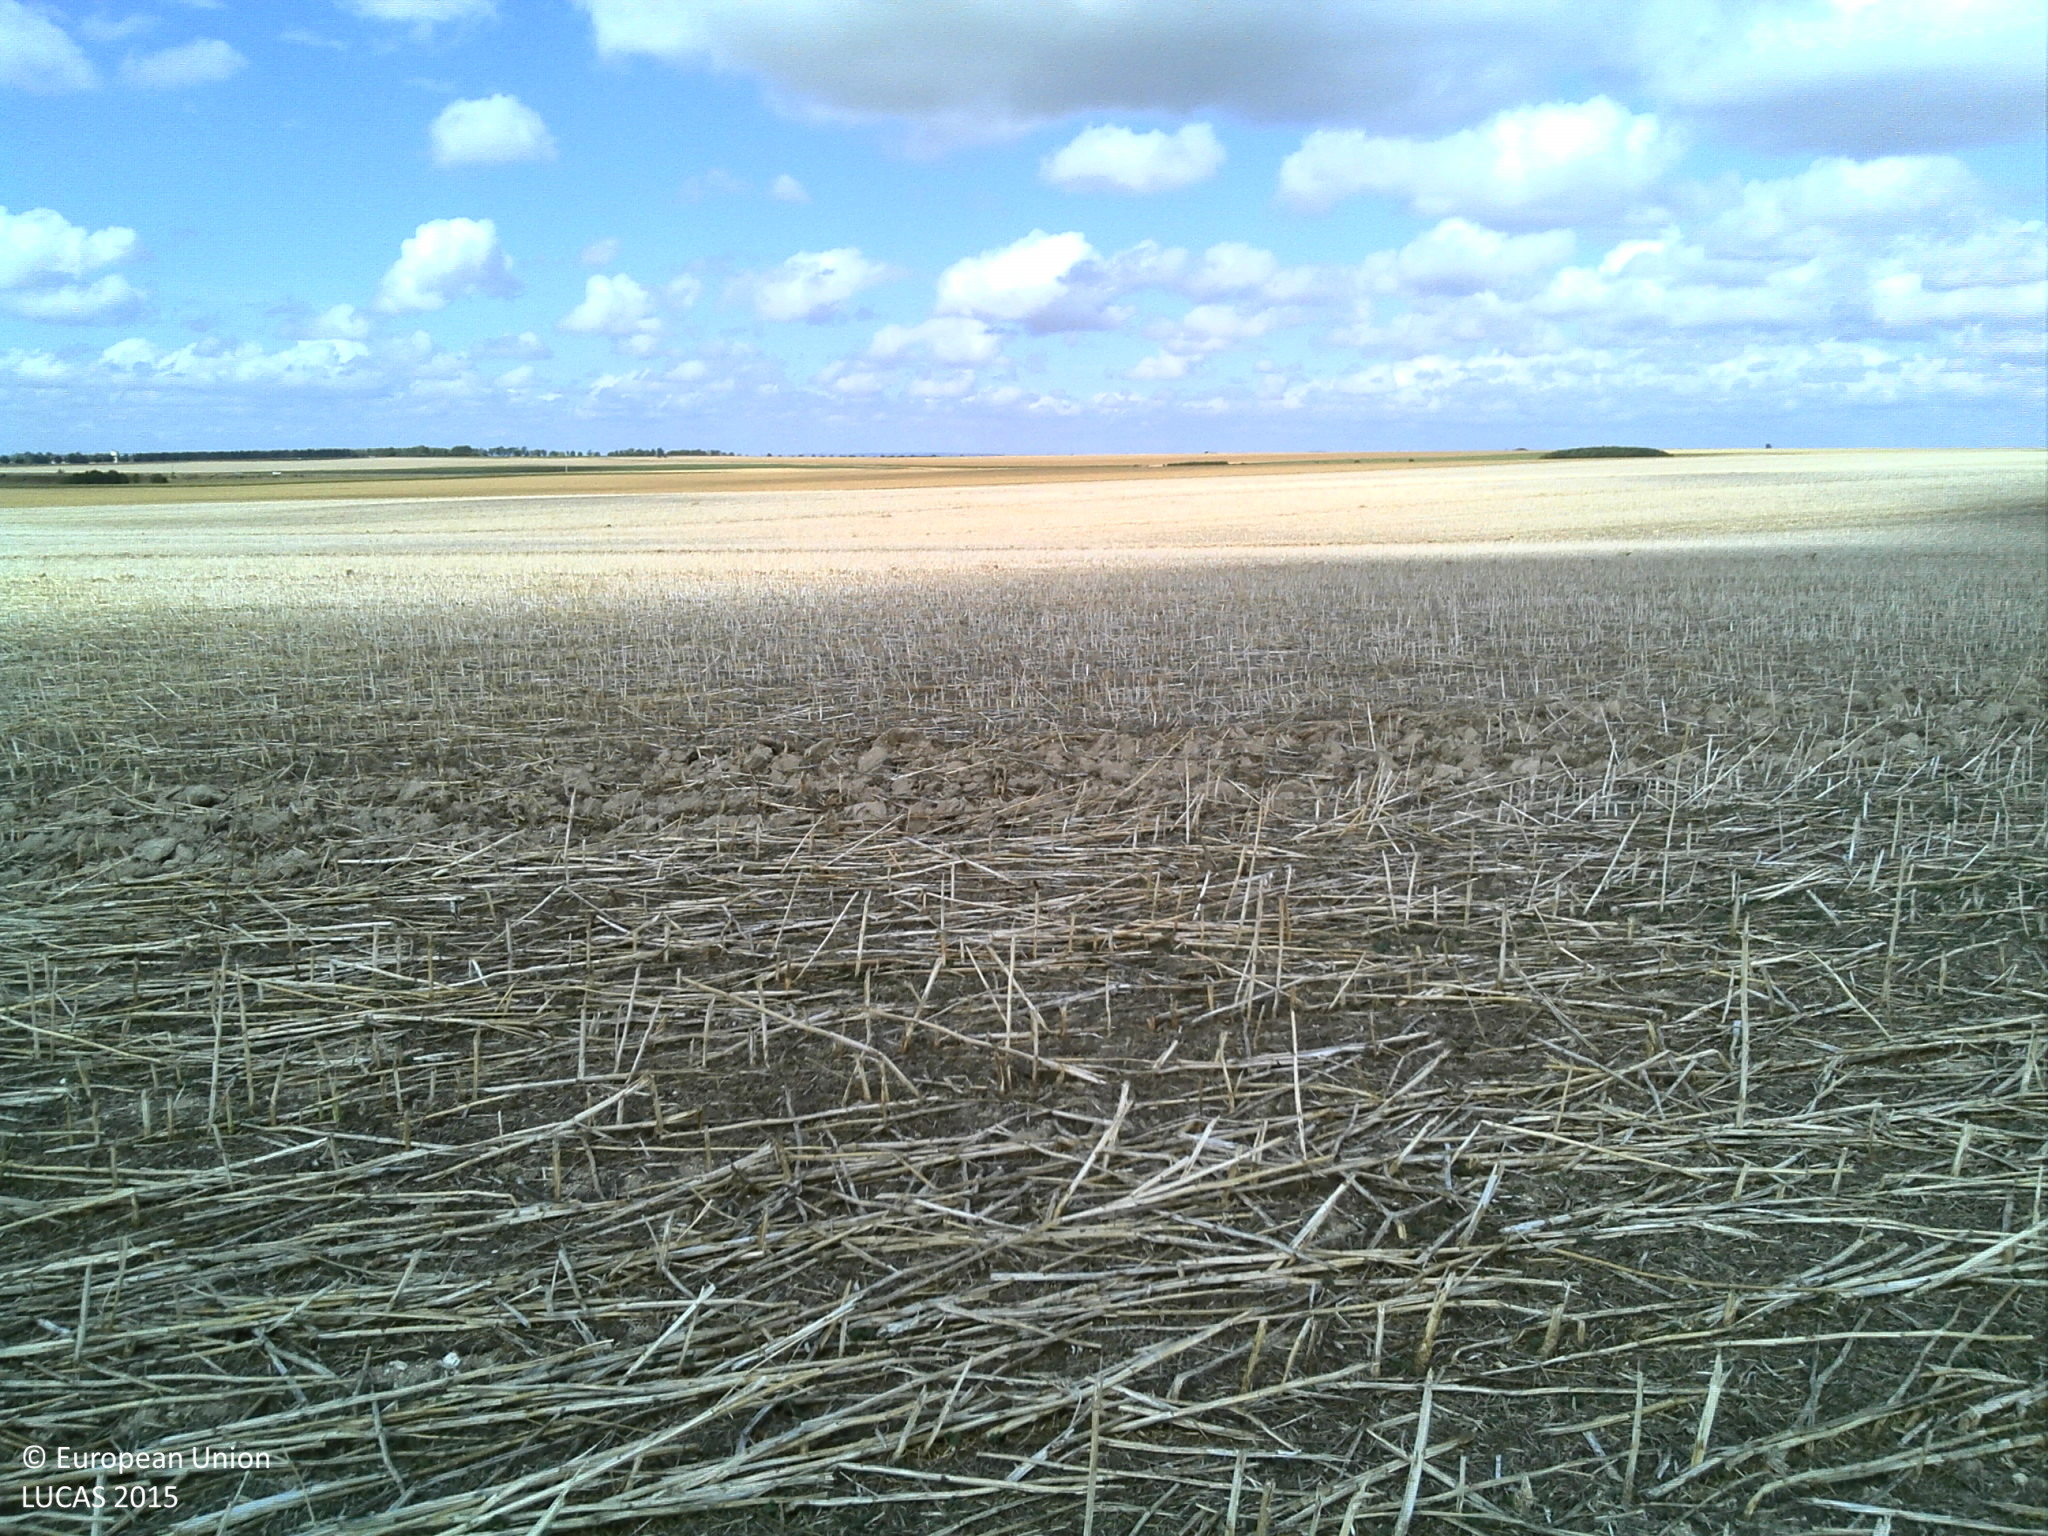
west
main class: Cropland
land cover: Rape and turnip rape
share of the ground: > 75 %
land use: Agriculture (excluding fallow land and kitchen gardens)
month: August
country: FR
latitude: 48.7406
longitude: 4.2441
